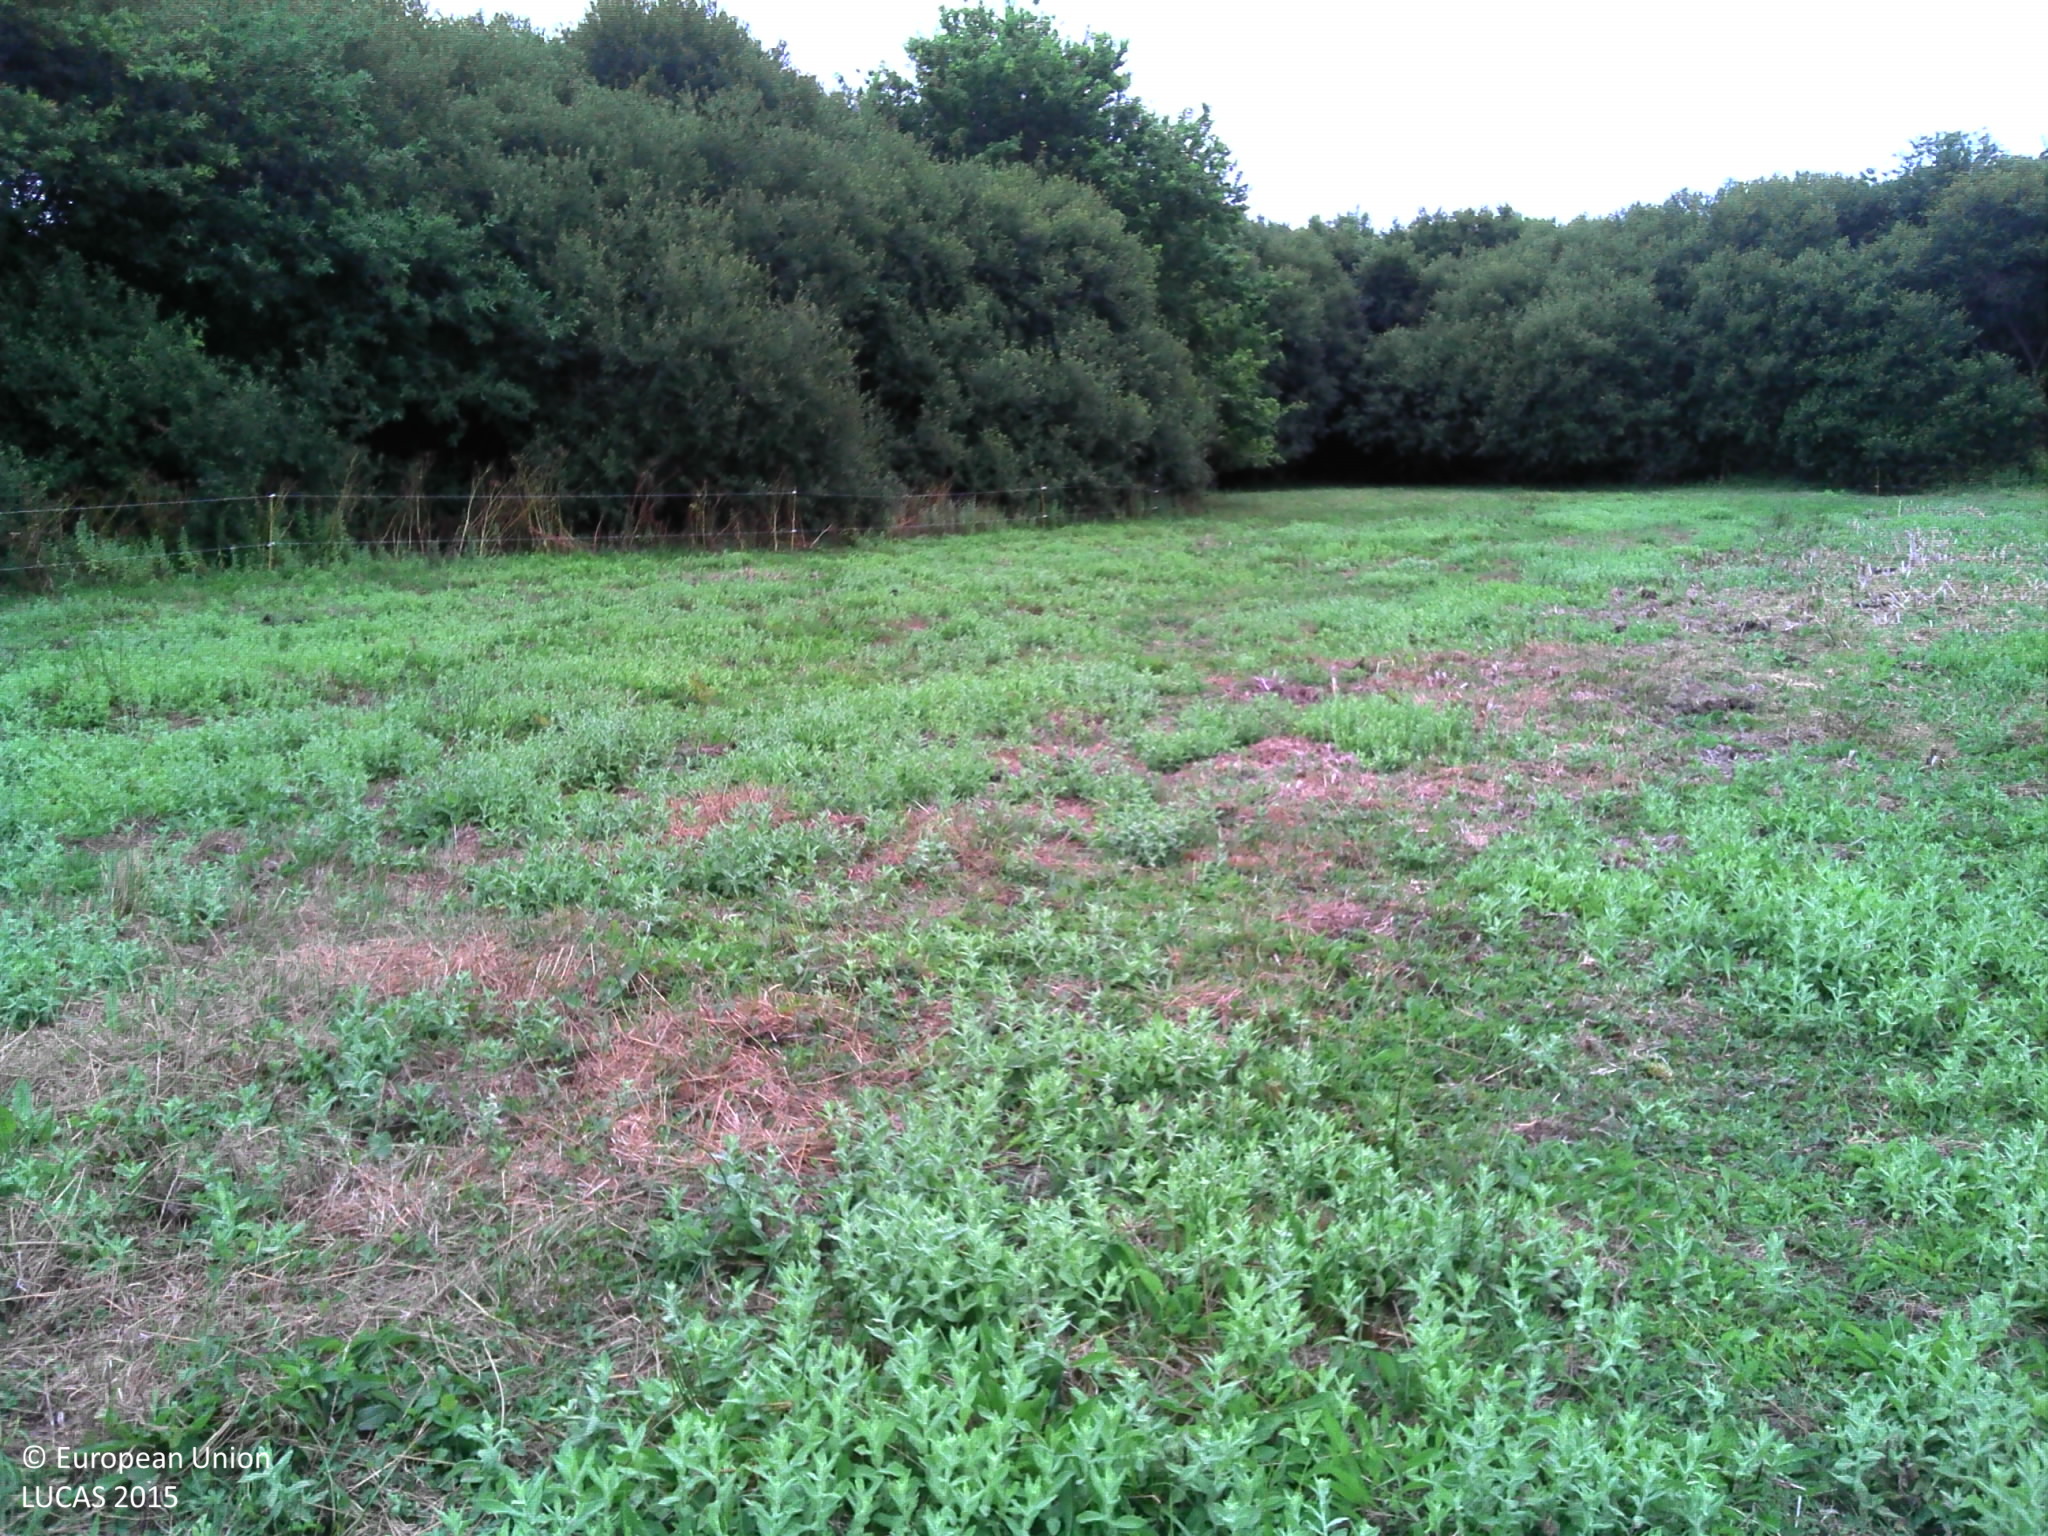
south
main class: Grassland
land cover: Spontaneously vegetated surfaces
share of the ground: > 75 %
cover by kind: herbaceous plants 90 %, unconsolidated bare surface 10 %
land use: Agriculture (excluding fallow land and kitchen gardens)
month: July
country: FR
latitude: 47.6787
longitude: -3.2170
